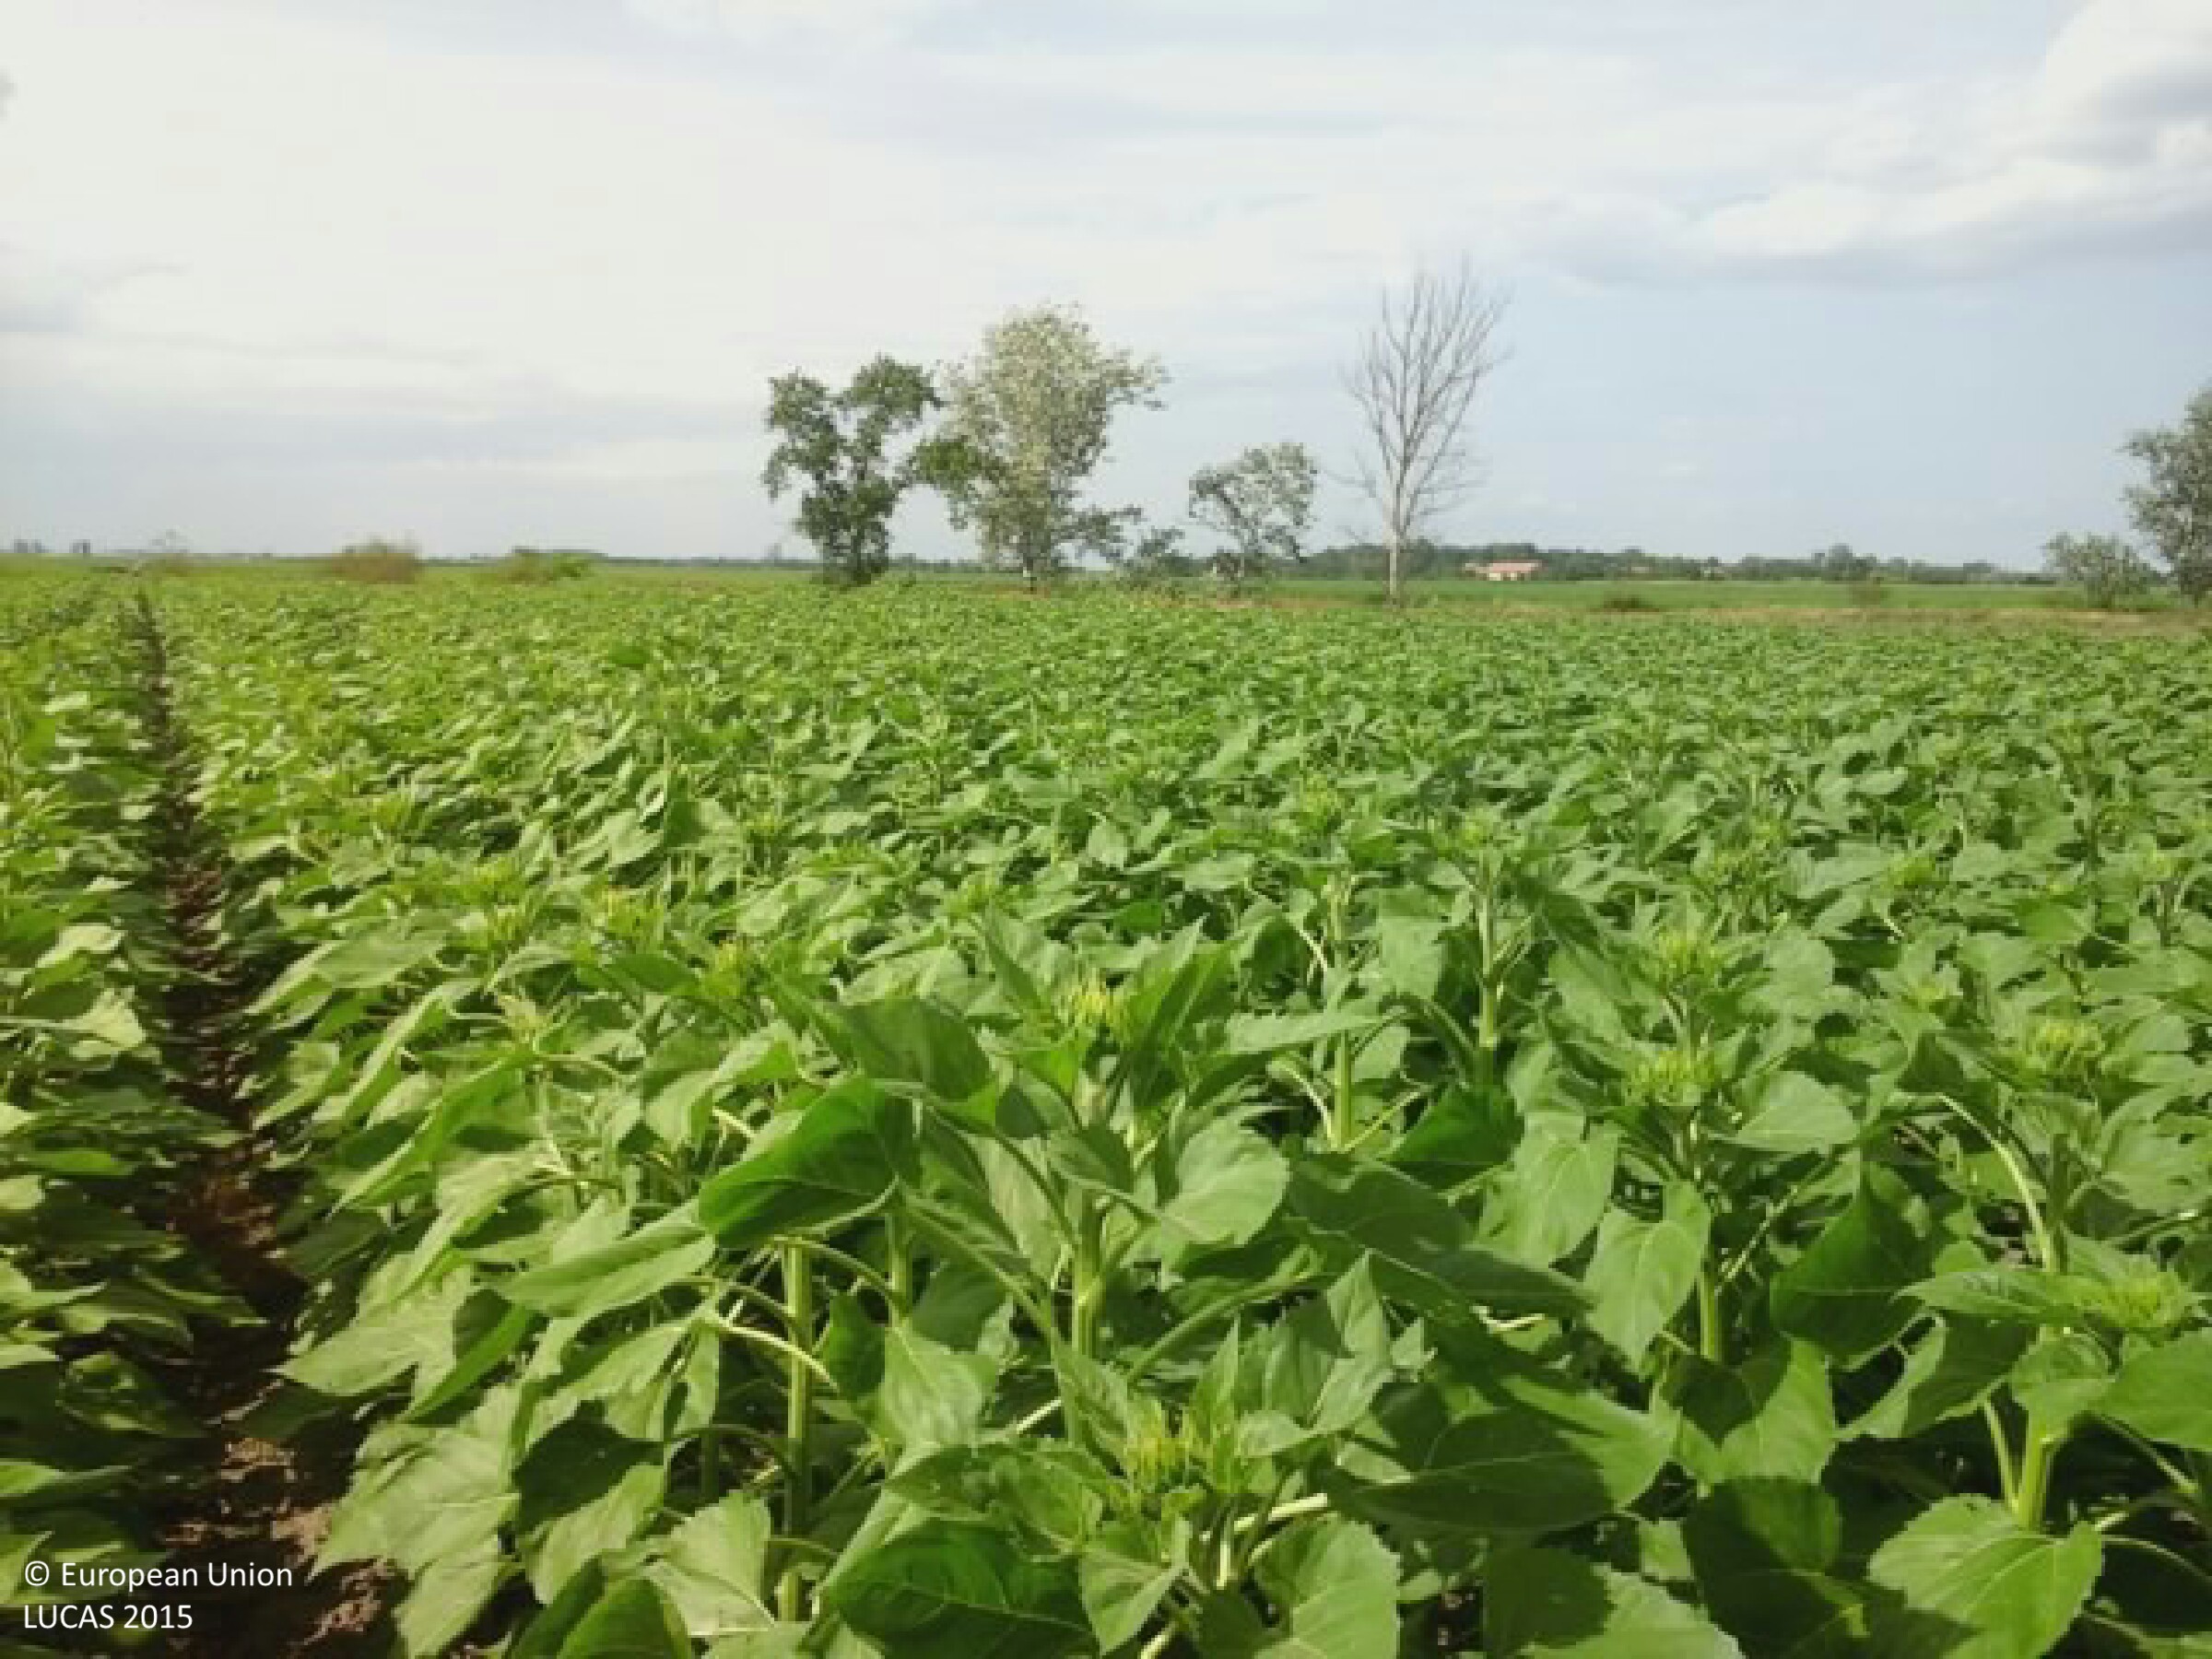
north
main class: Cropland
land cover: Sunflower
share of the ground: > 75 %
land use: Agriculture (excluding fallow land and kitchen gardens)
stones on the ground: < 10 %
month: July
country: HU
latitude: 47.1445
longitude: 19.0494
